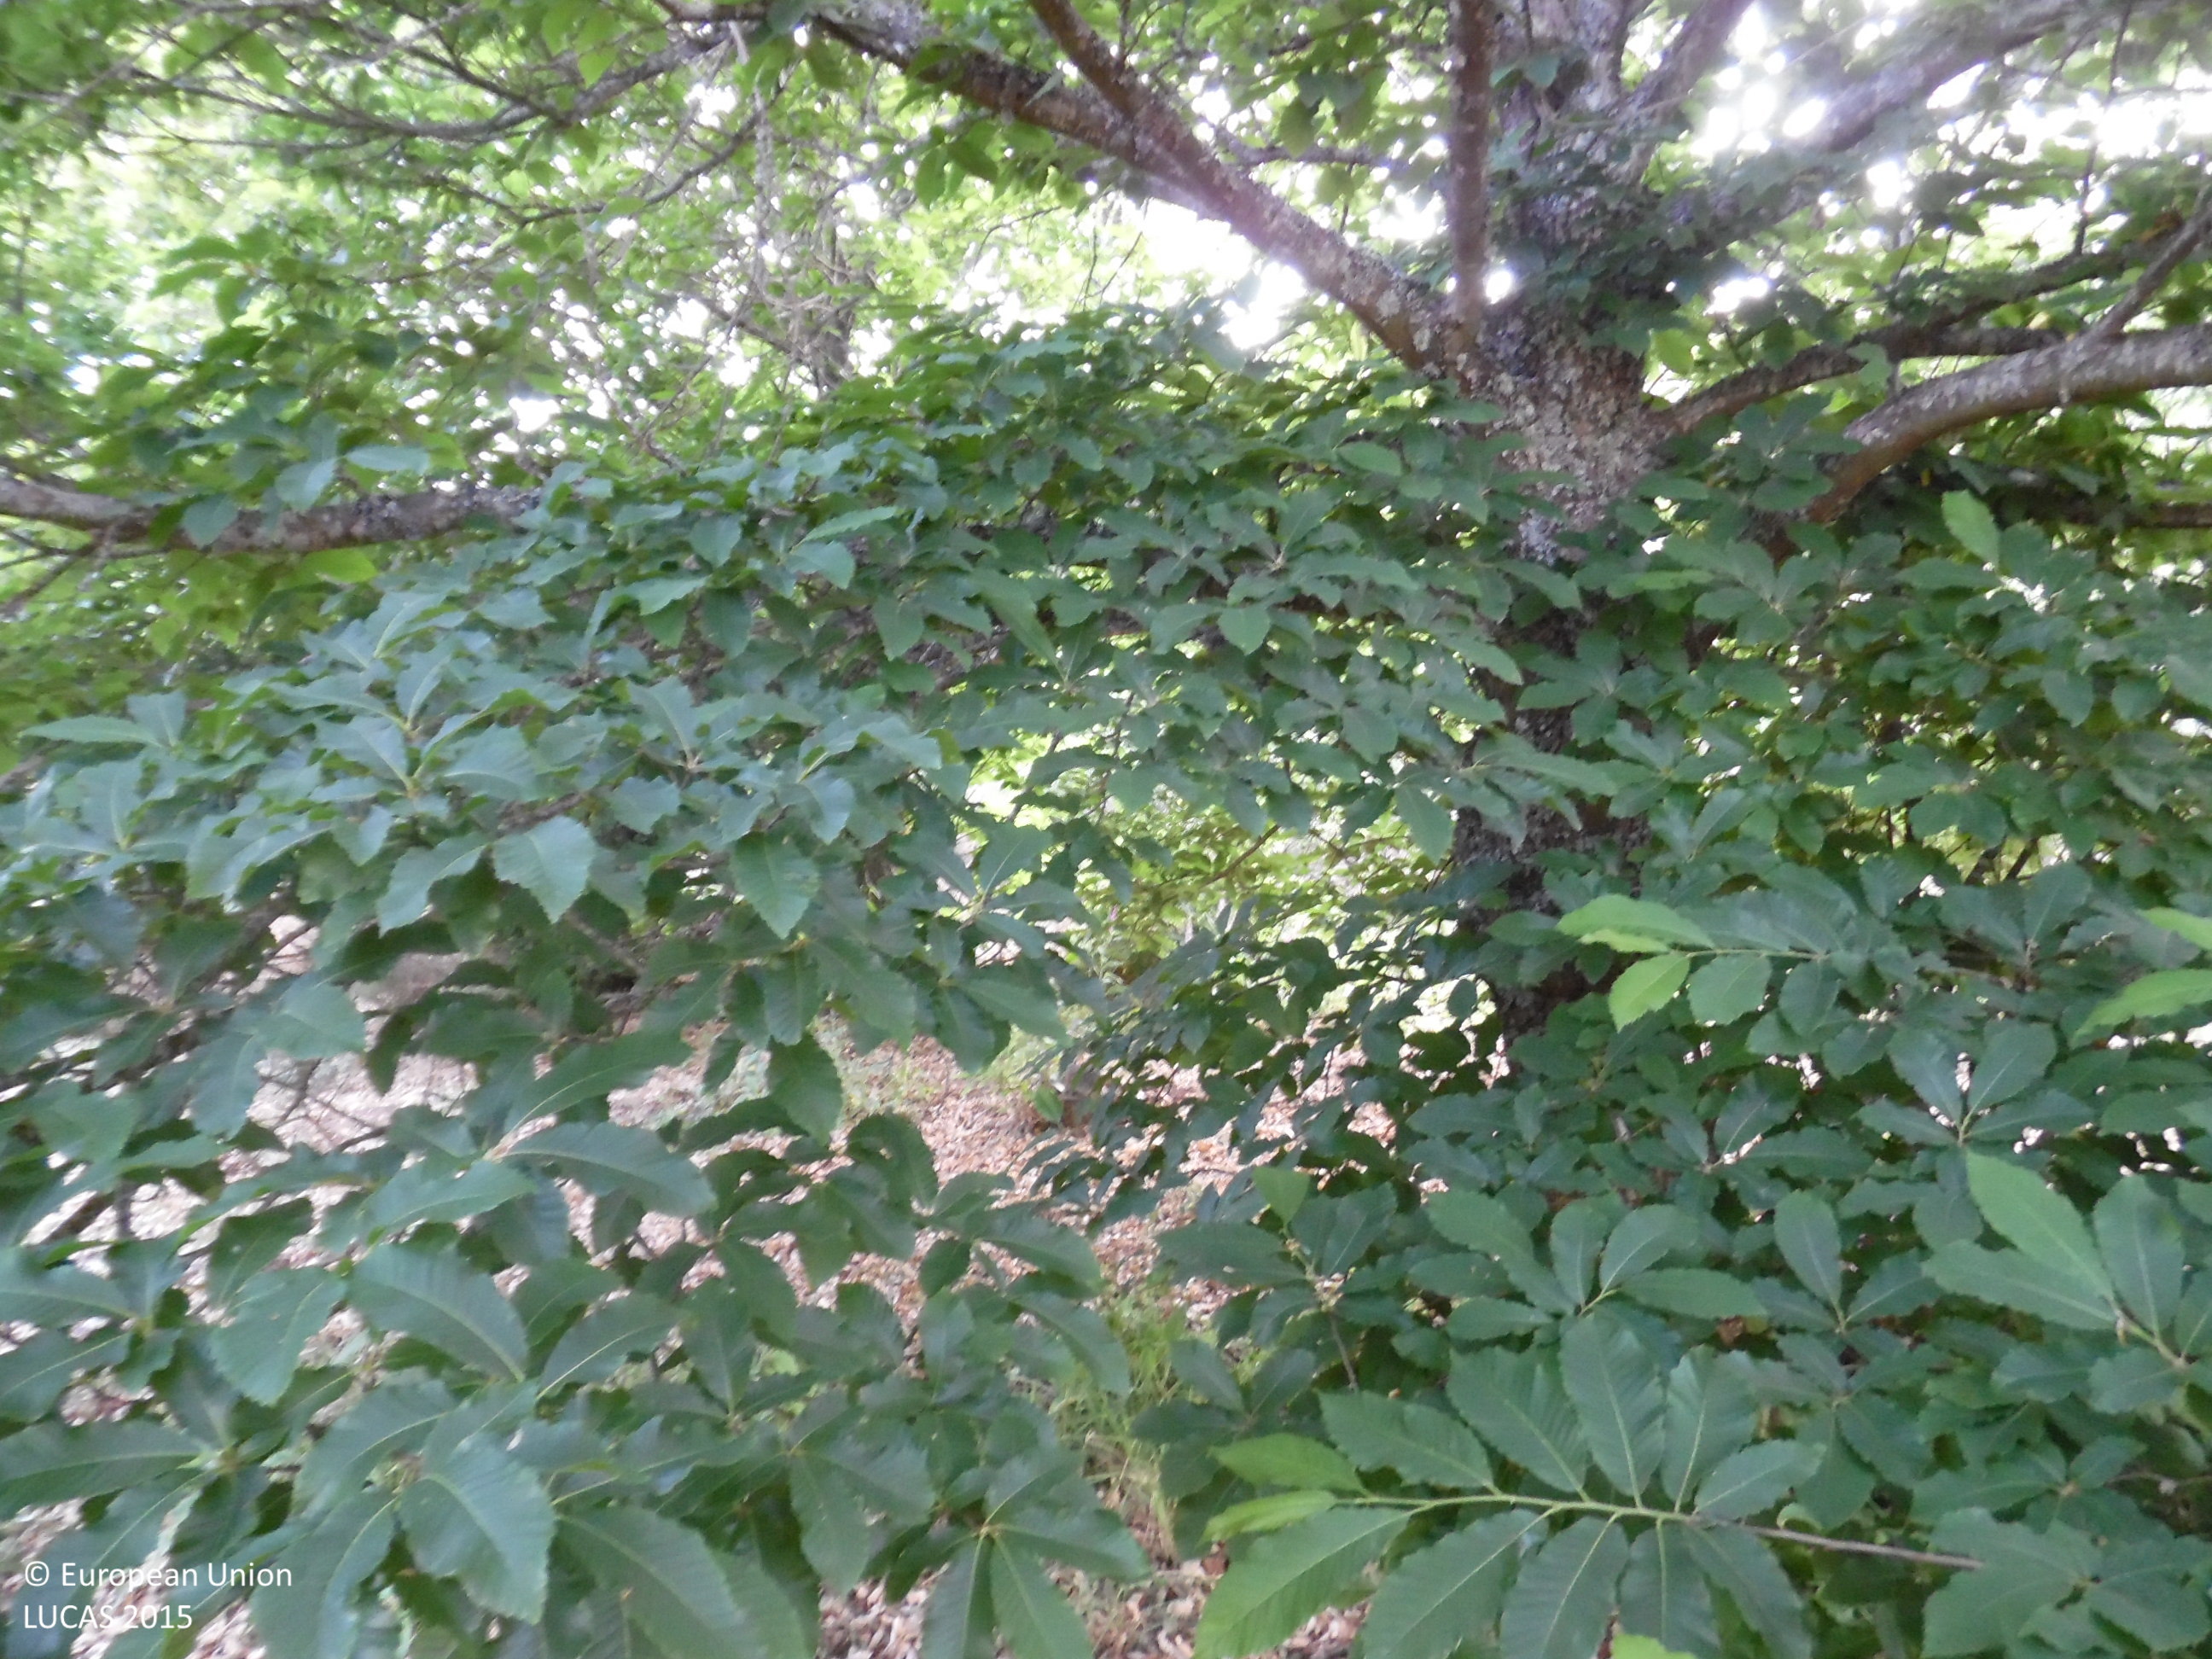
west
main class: Woodland
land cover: Broadleaved woodland
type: thermophilous deciduous forest
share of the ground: > 75 %
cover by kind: broadleaved forest trees 90 %, shrubs 5 %, herbaceous plants 5 %
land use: Forestry
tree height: > 5 m
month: June
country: ES
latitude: 42.6847
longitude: -5.8355
